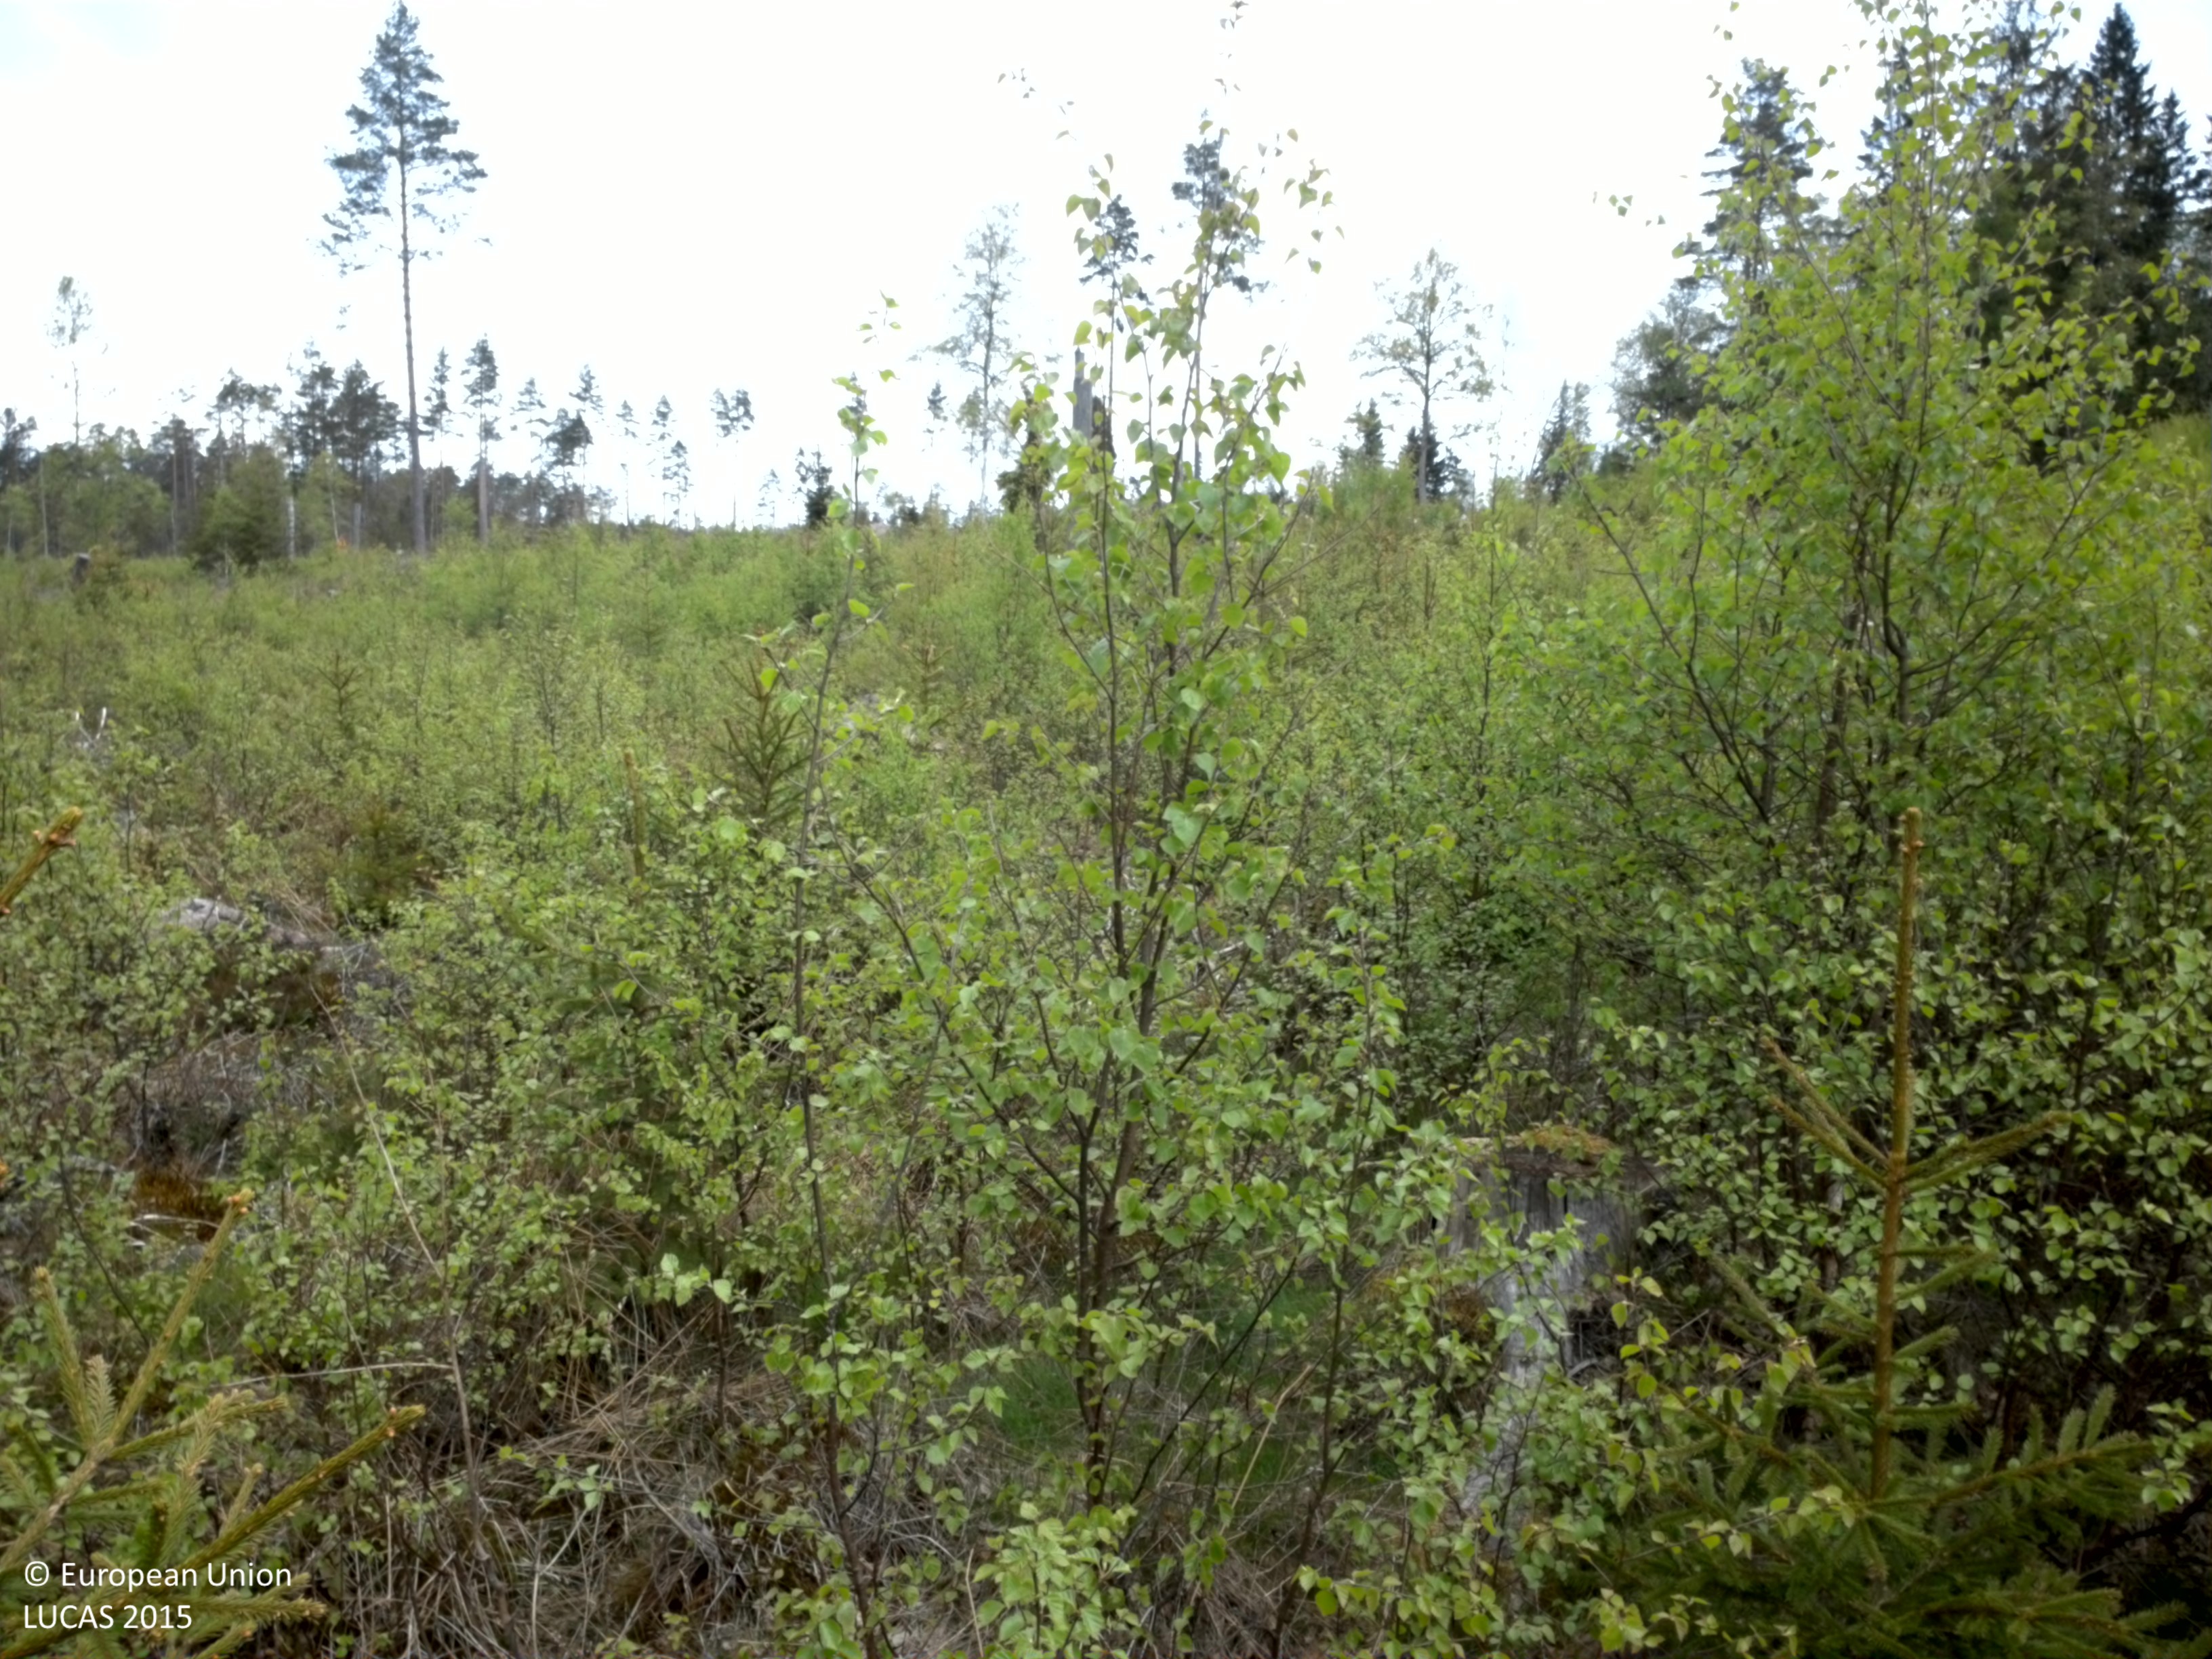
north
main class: Woodland
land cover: Spruce dominated mixed woodland
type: boreal forest
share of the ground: 50 - 75 %
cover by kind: broadleaved forest trees 40 %, coniferous forest trees 35 %, shrubs 10 %, herbaceous plants 10 %, lichens and mosses 5 %
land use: Forestry
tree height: < 5 m
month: May
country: SE
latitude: 56.9099
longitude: 15.2366
